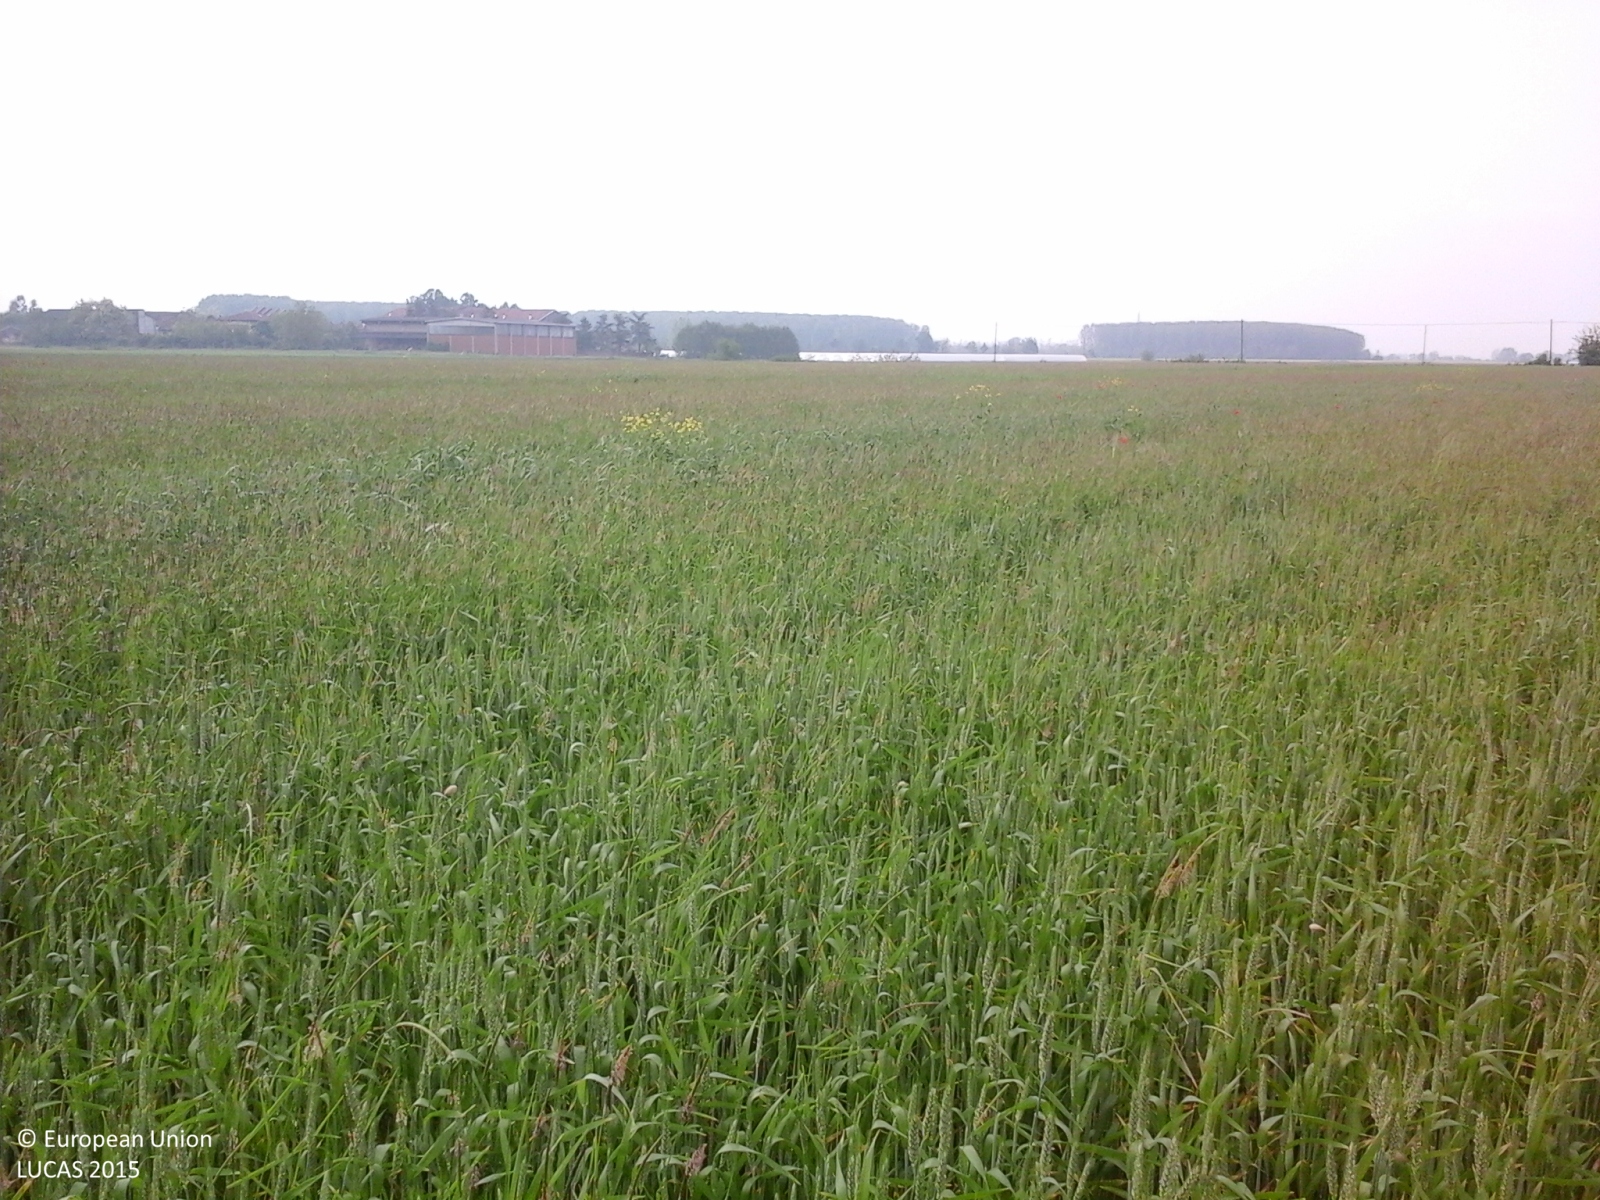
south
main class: Cropland
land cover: Common wheat
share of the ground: > 75 %
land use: Agriculture (excluding fallow land and kitchen gardens)
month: May
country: IT
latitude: 45.0339
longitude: 10.6208
